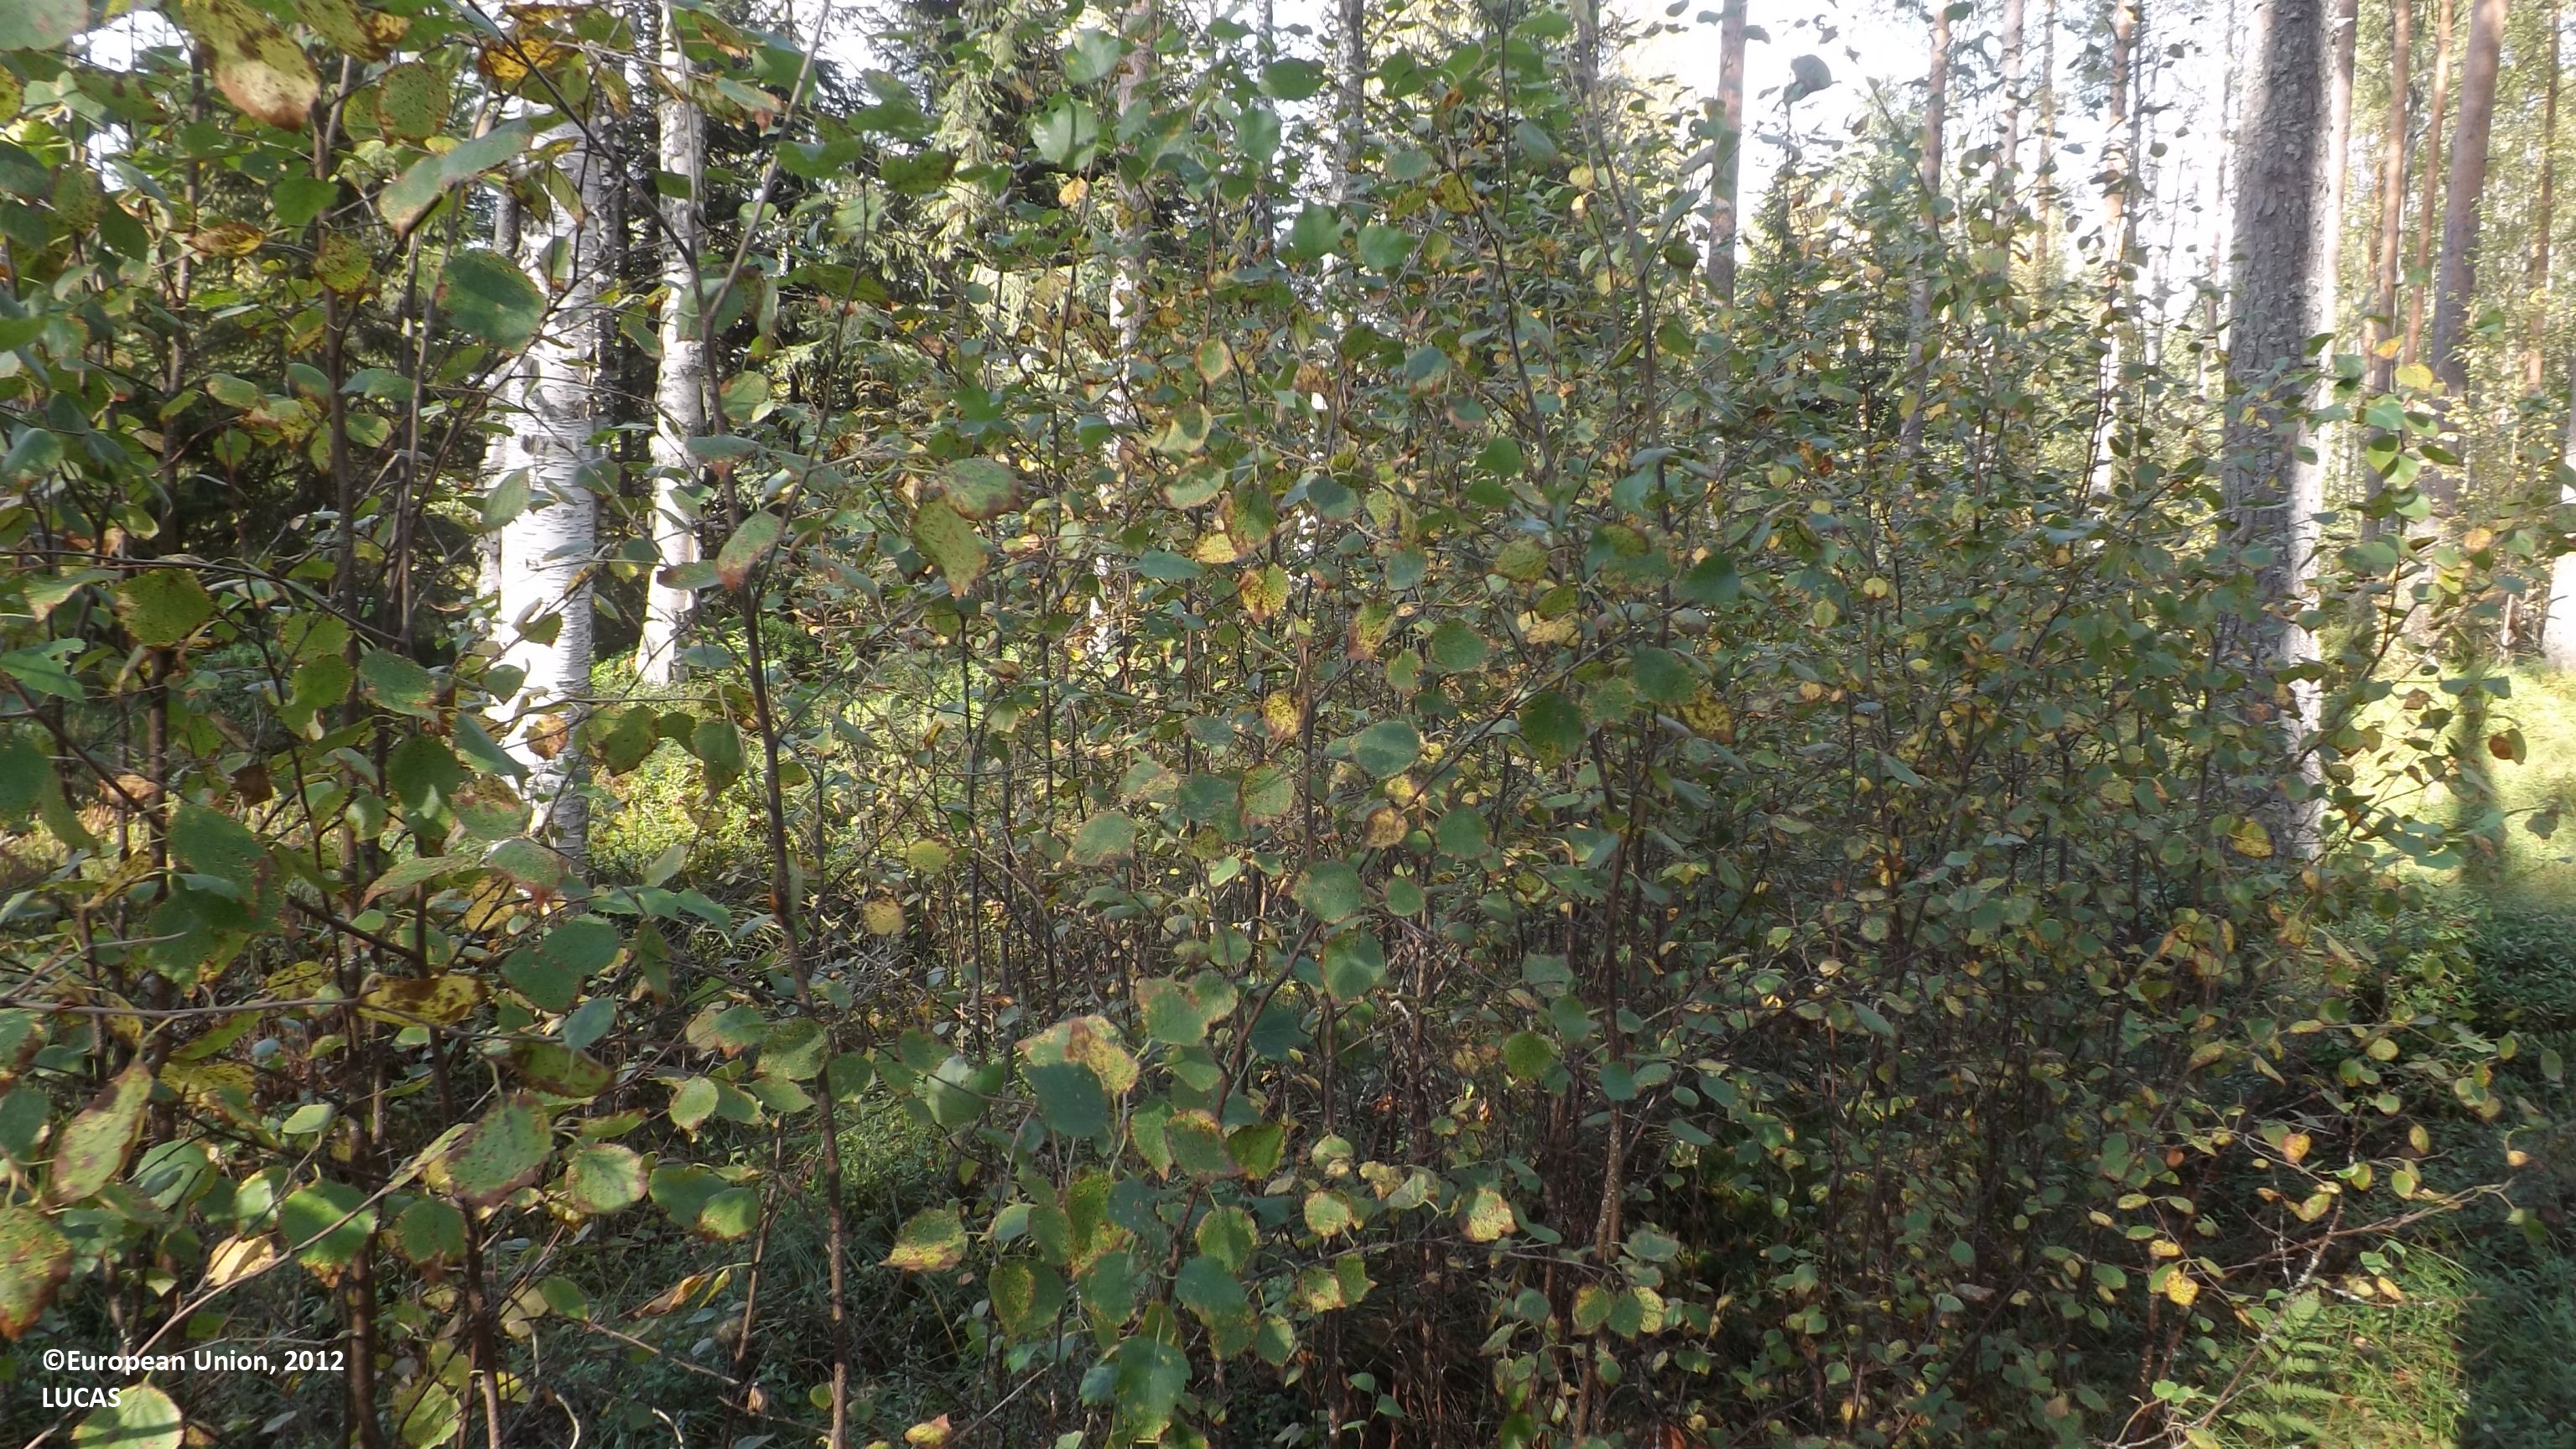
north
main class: Woodland
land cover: Pine dominated mixed woodland
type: boreal forest
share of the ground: 50 - 75 %
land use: Forestry
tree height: > 5 m
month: August
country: FI
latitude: 63.9076
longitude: 23.7358
